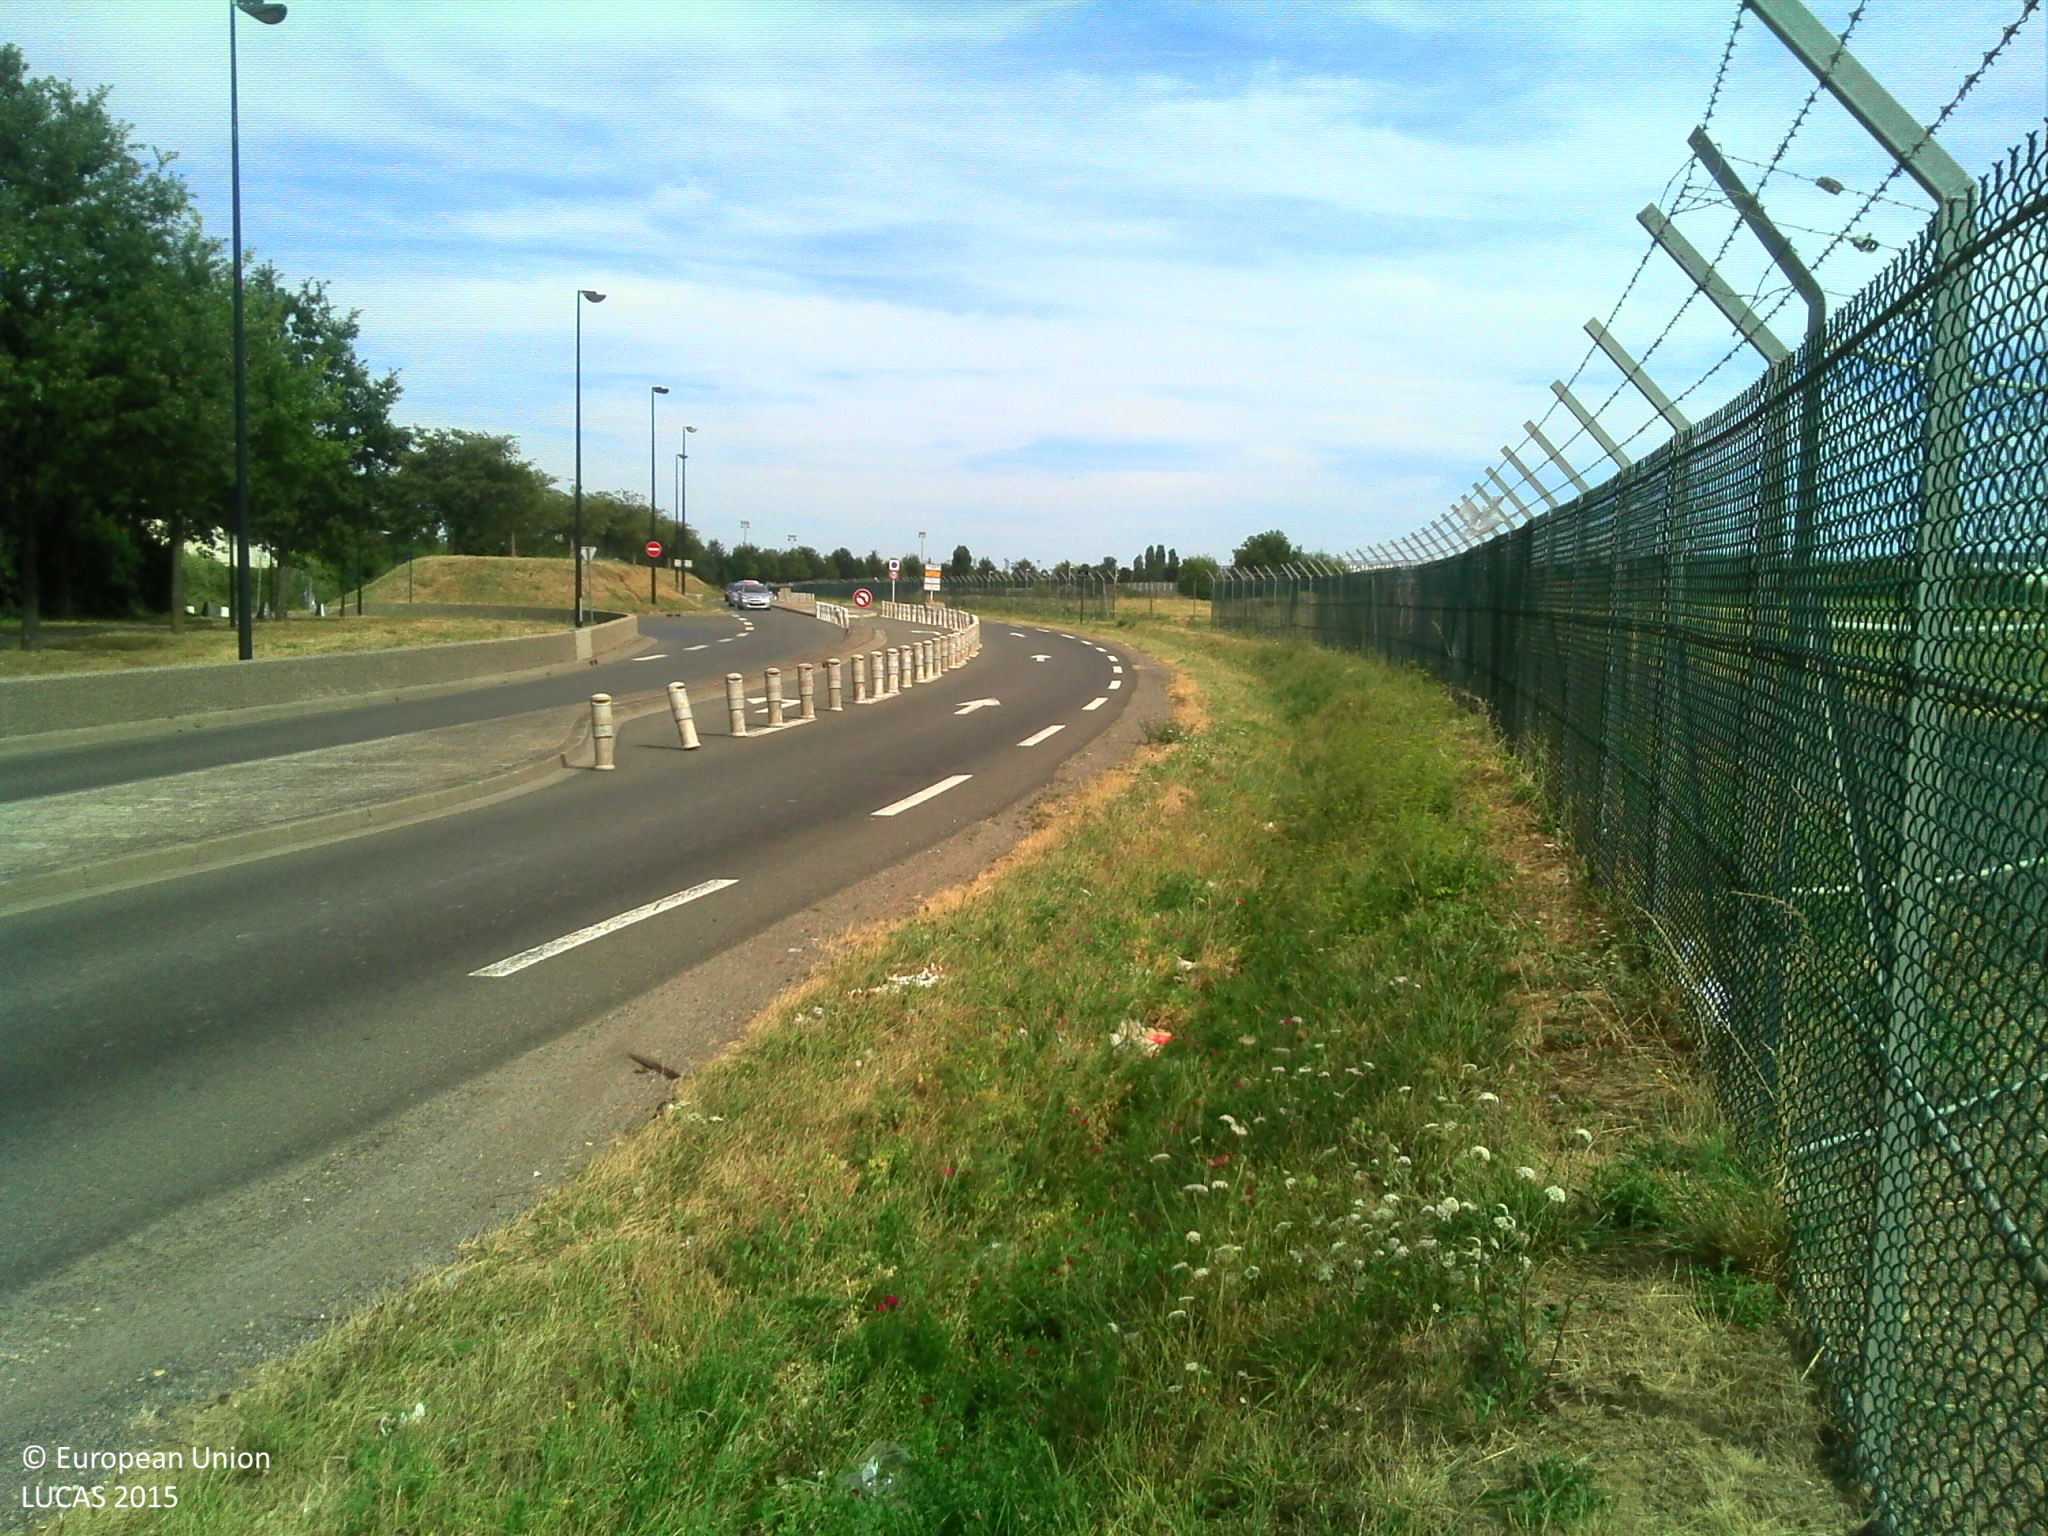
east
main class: Grassland
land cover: Grassland without tree/shrub cover
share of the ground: > 75 %
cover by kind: herbaceous plants 100 %
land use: Air transport
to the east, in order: Grassland without tree/shrub cover
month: August
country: FR
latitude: 48.7372
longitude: 2.3874
